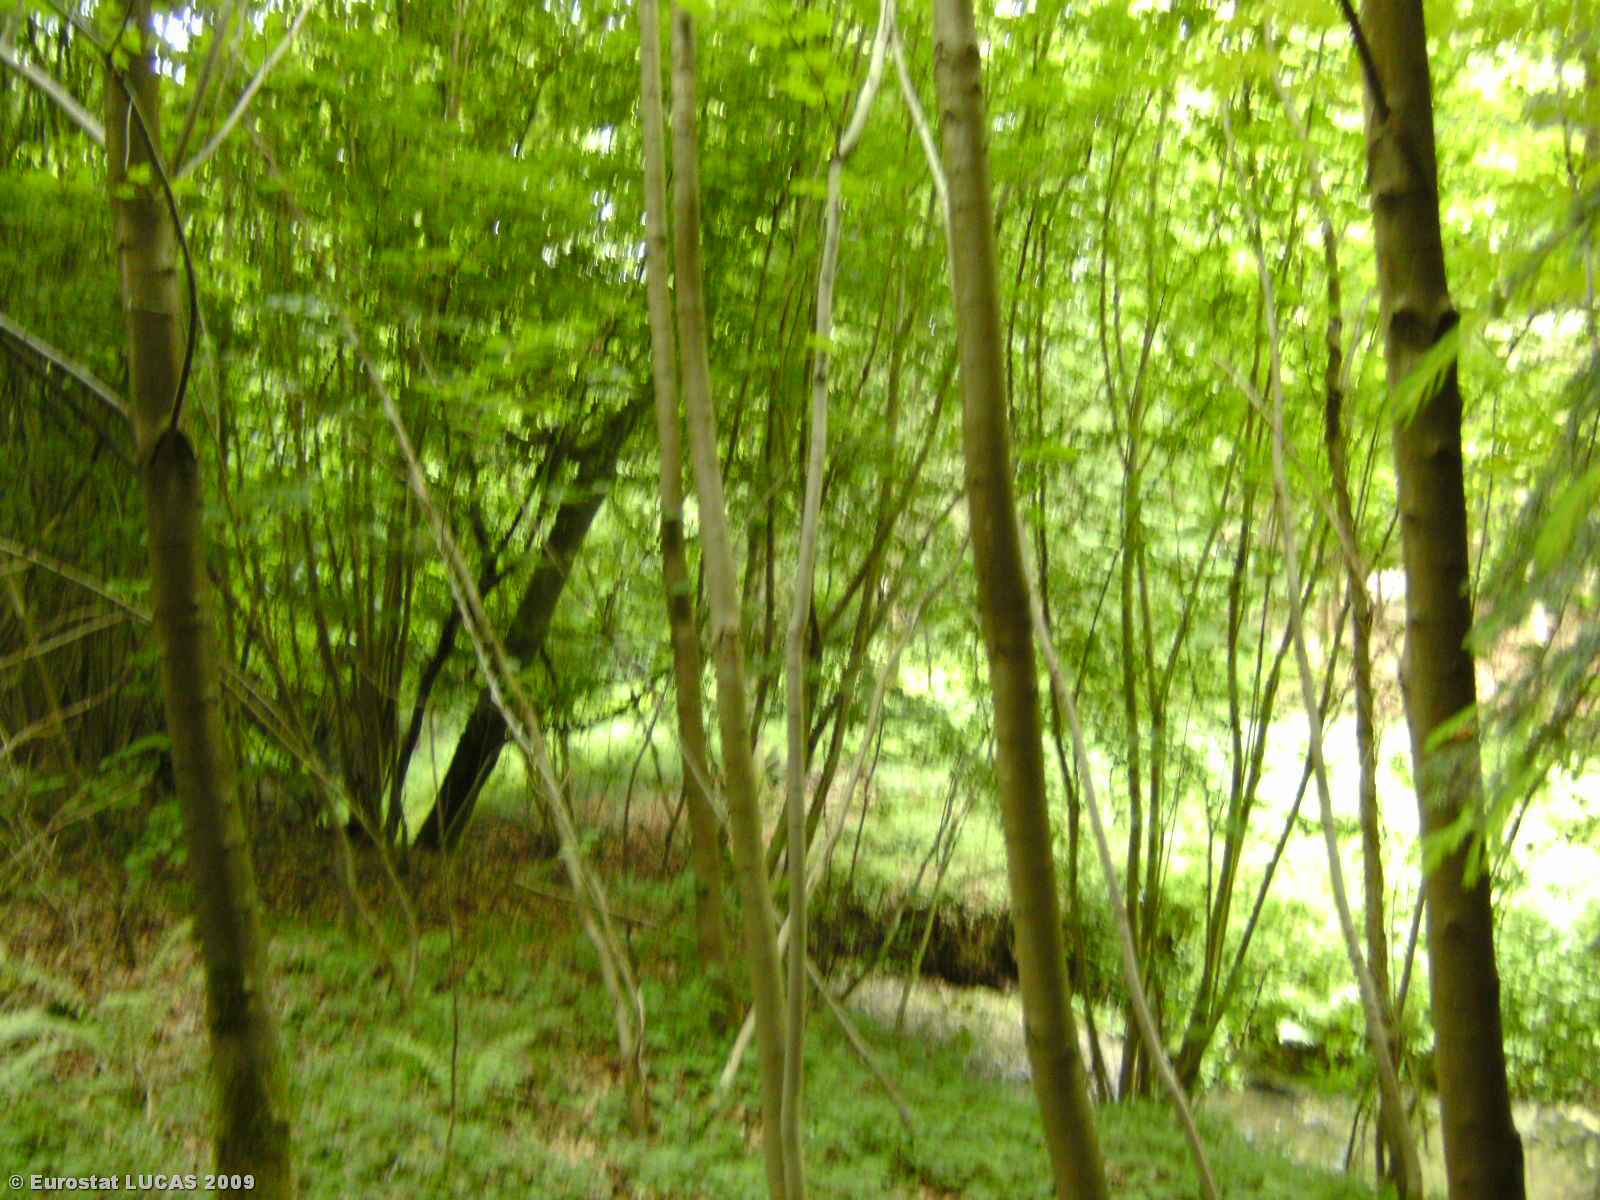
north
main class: Woodland
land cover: Broadleaved woodland
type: hemiboreal forest and nemoral coniferous forest and mixed broadleaved-coniferous forest
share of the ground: > 75 %
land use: Forestry
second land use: Amenities, museums, leisure
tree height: > 5 m
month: June
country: LU
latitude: 49.5788
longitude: 6.1408
